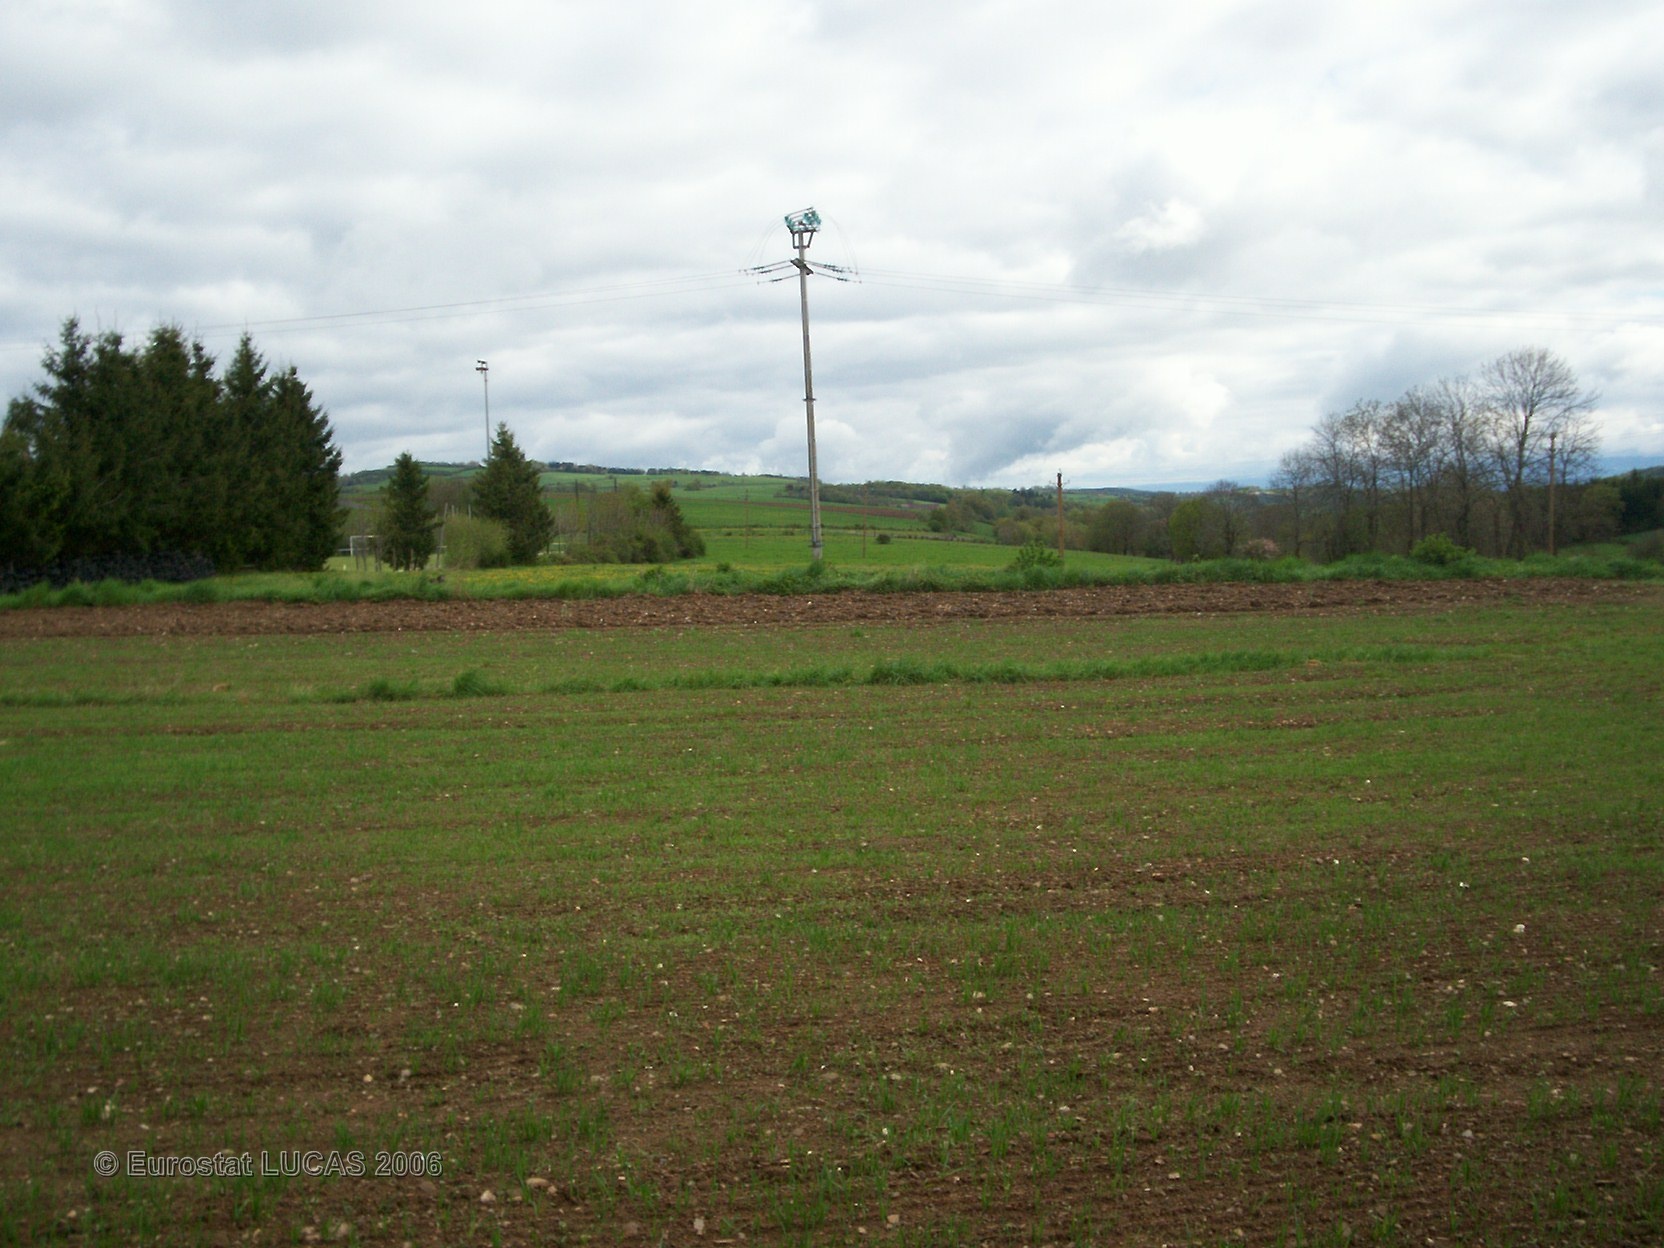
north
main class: Grassland
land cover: Grassland without tree/shrub cover
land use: Agriculture (excluding fallow land and kitchen gardens)
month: May
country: FR
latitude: 45.1795
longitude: 3.2449
